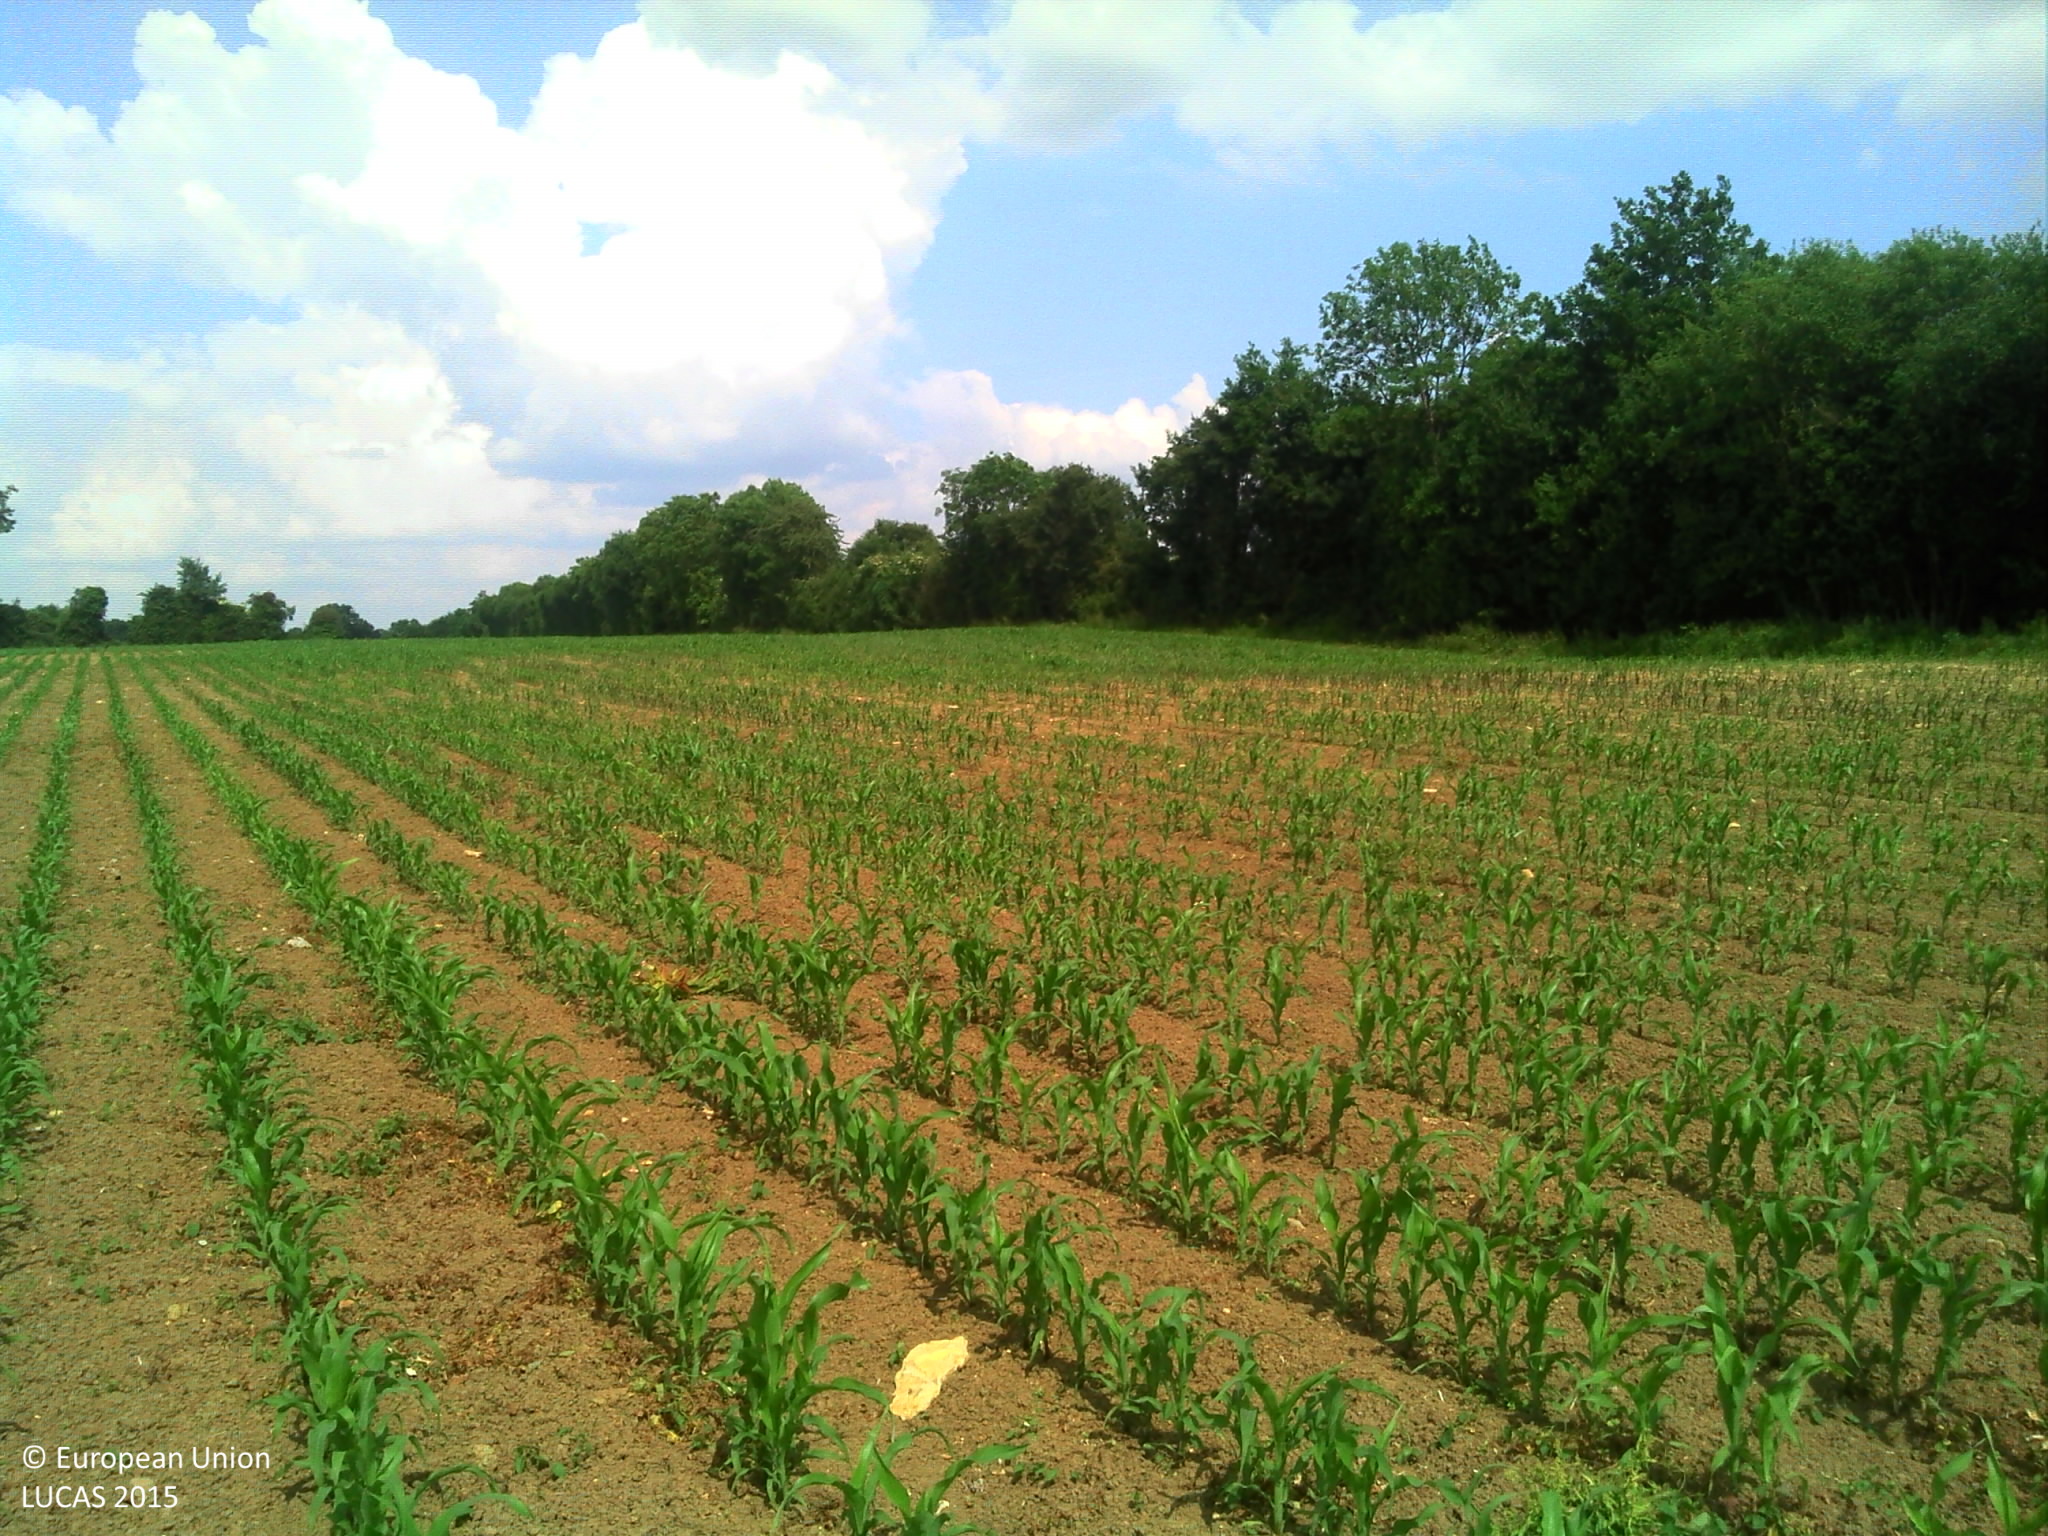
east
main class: Cropland
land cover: Maize
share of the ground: 10 - 25 %
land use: Agriculture (excluding fallow land and kitchen gardens)
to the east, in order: Maize; Lines of trees; Ditches and canals; Grass margins; Tracks; Grass margins; Ditches and canals; Lines of trees; Other bare soil; Managed hedges; Grassland without tree/shrub cover
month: June
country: FR
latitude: 48.4692
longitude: 0.1388
